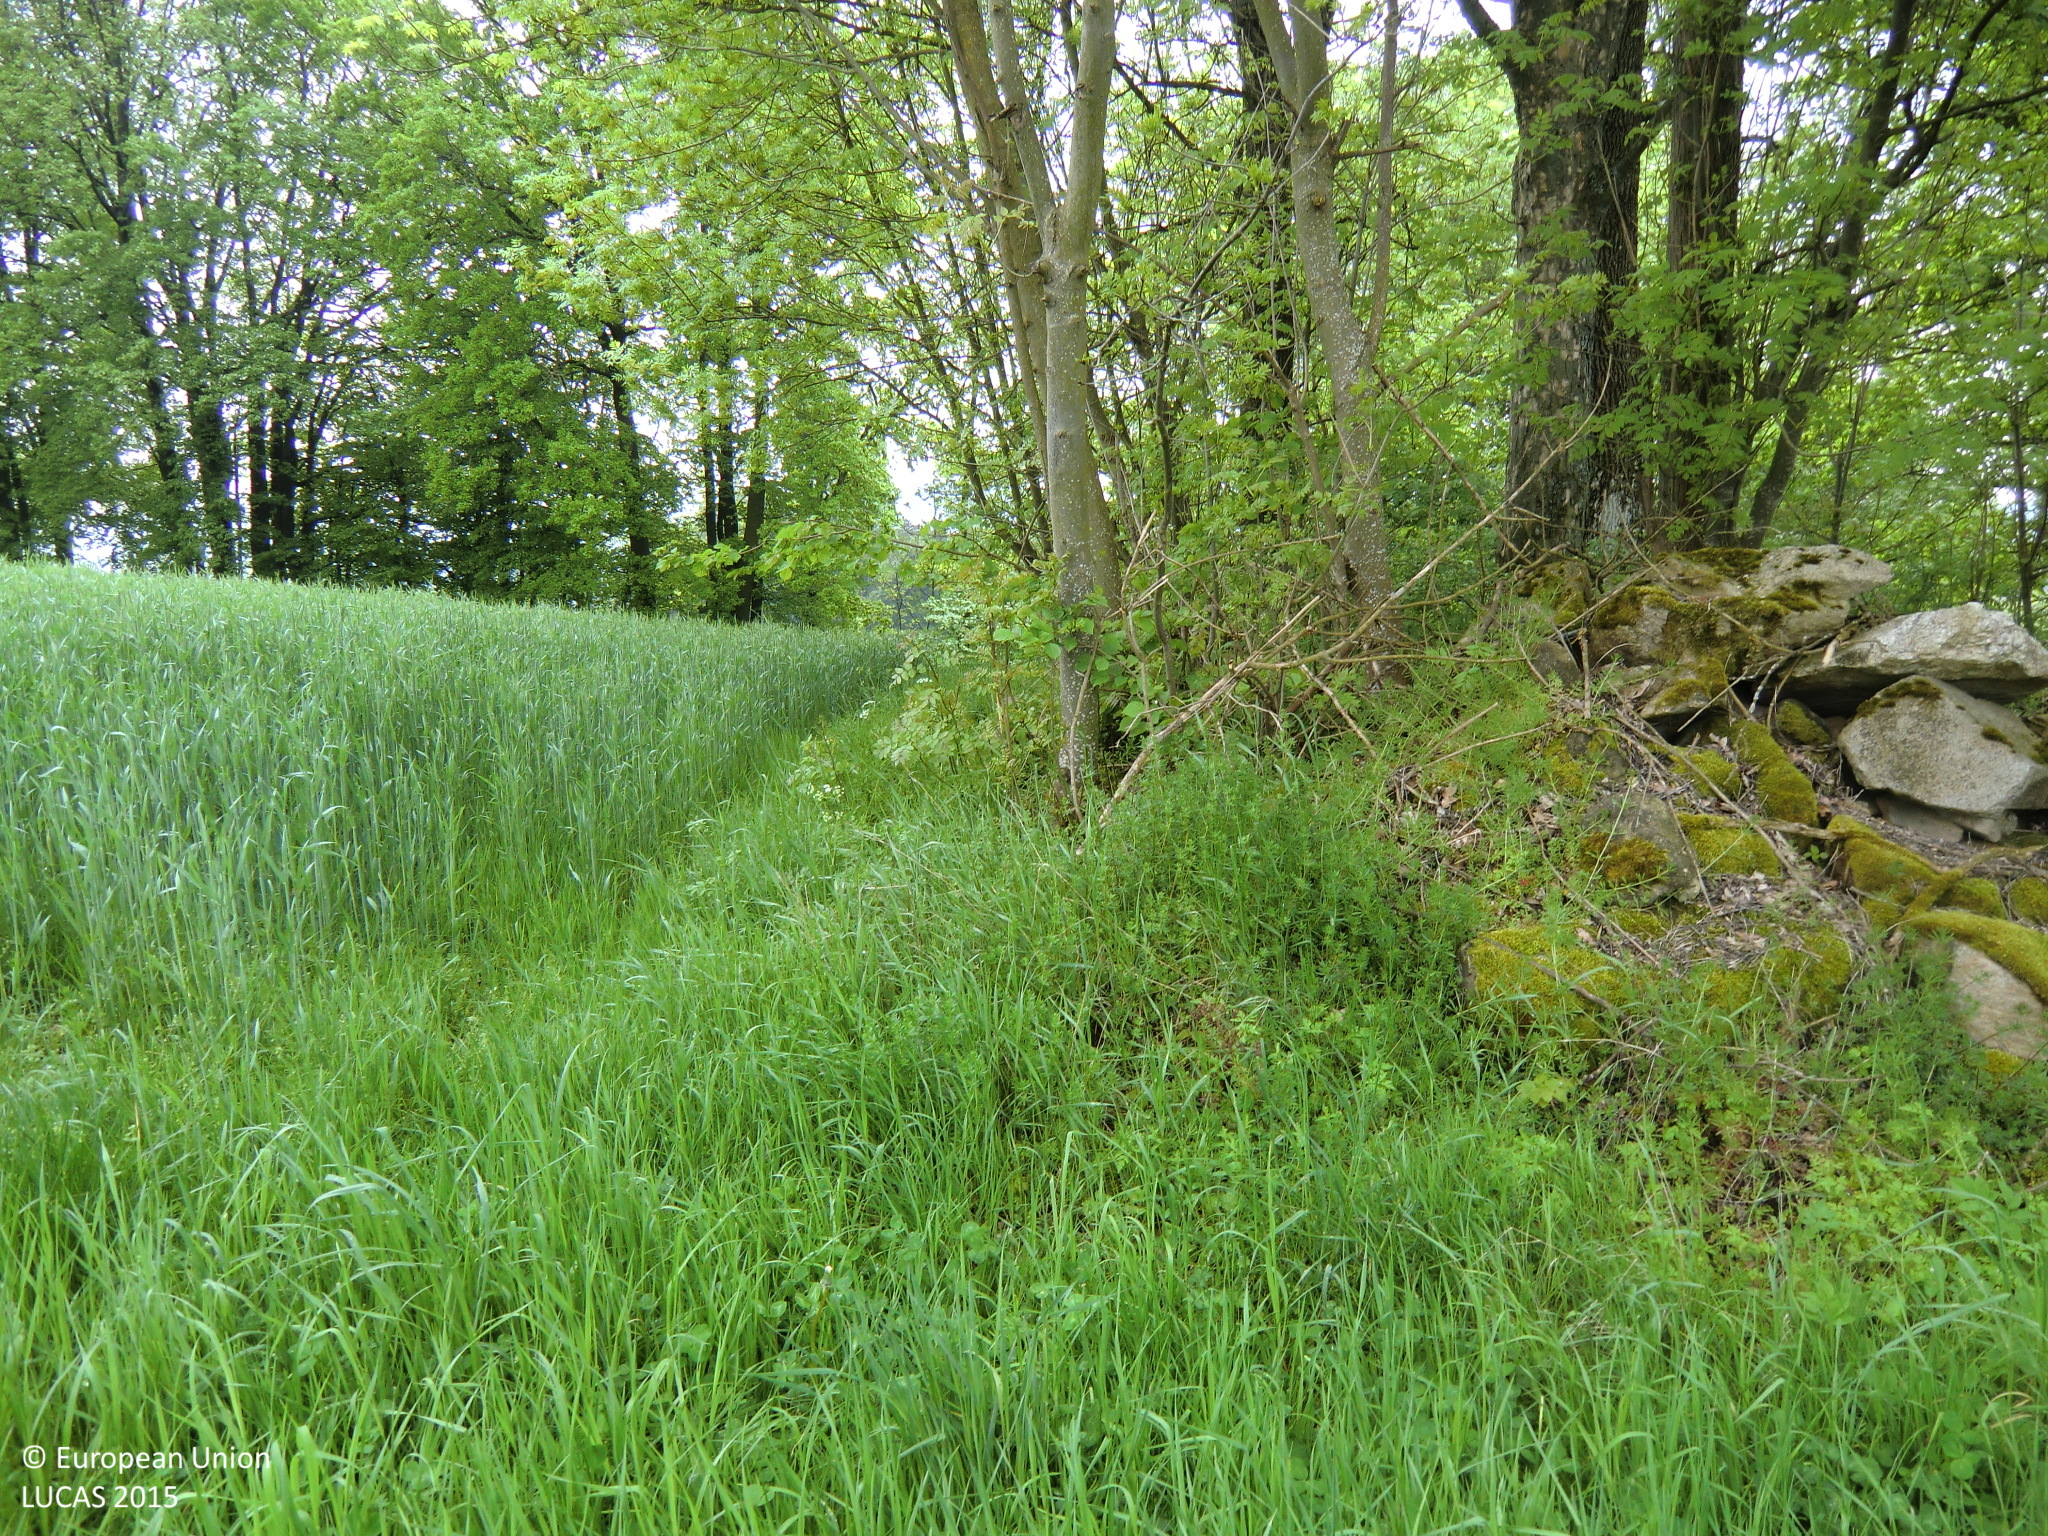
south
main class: Cropland
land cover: Clovers
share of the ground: 25 - 50 %
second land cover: Rye
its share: 25 - 50 %
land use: Agriculture (excluding fallow land and kitchen gardens)
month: May
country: AT
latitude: 48.3895
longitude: 14.3623
